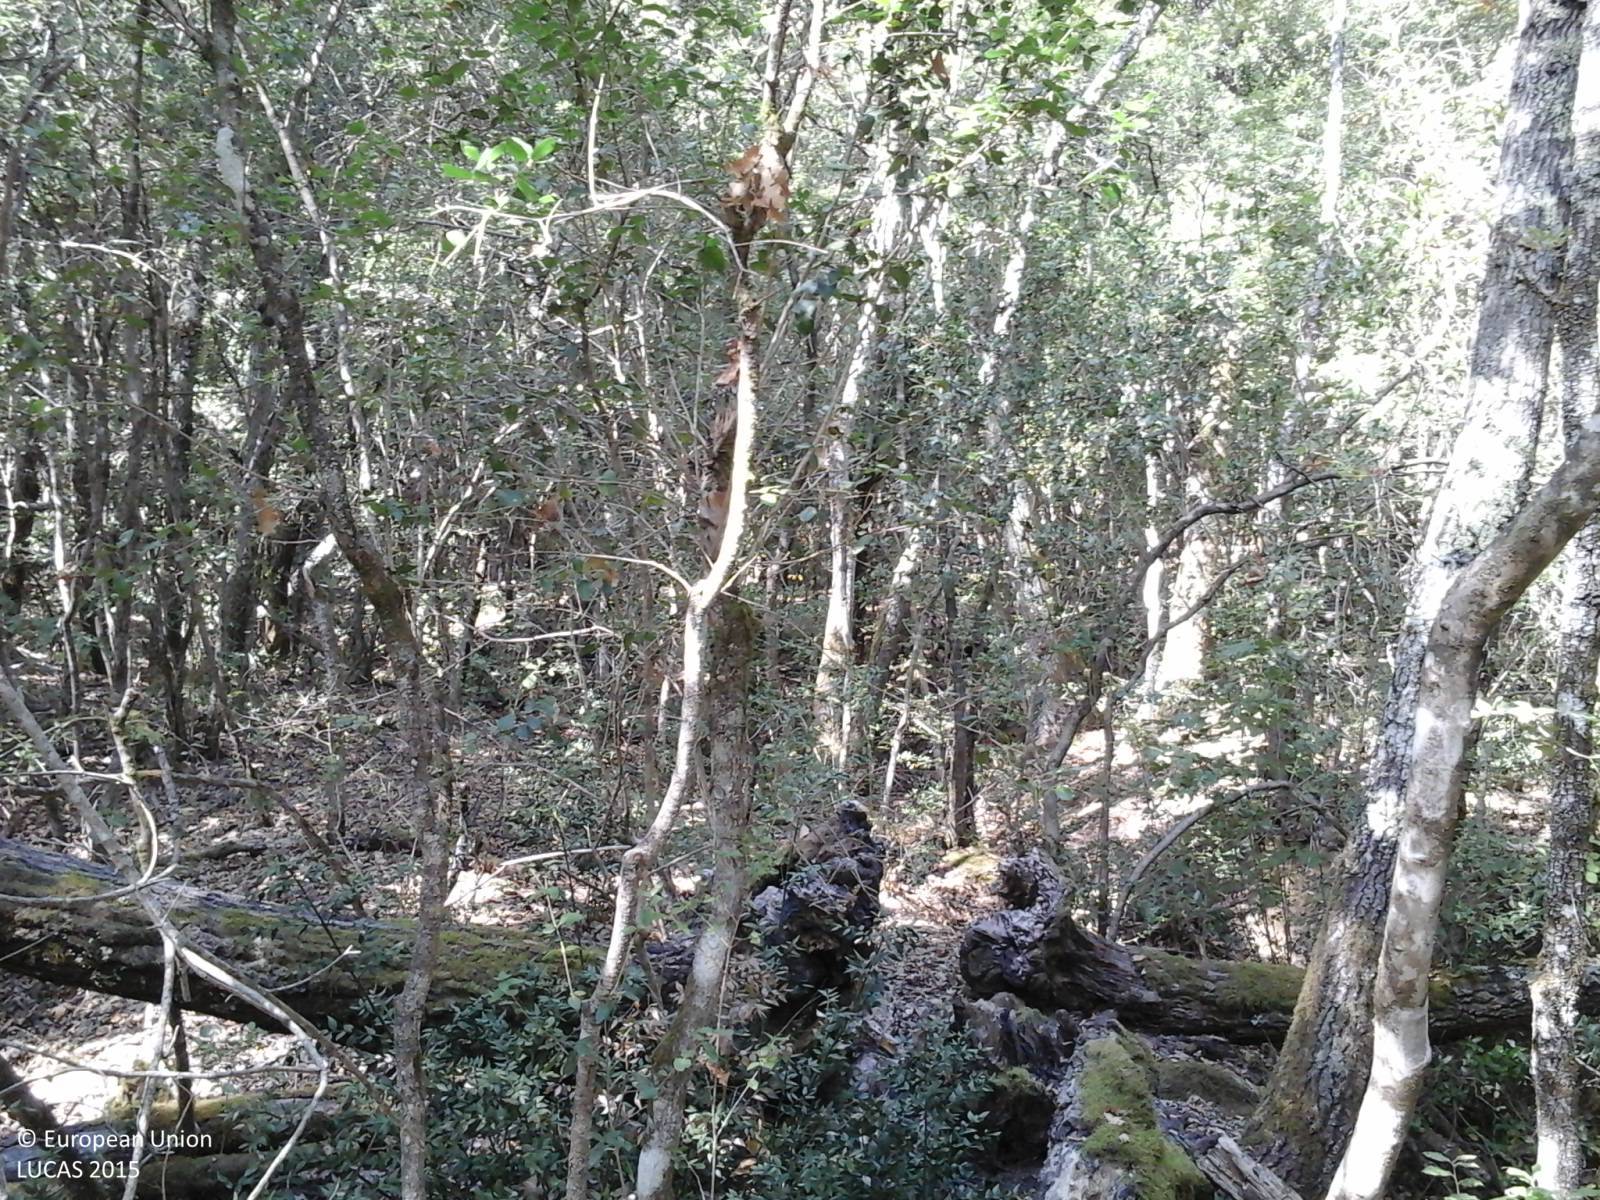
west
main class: Woodland
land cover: Broadleaved woodland
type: thermophilous deciduous forest
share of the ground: > 75 %
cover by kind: broadleaved forest trees 90 %, shrubs 10 %
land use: Forestry
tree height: > 5 m
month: September
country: IT
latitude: 43.1211
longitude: 10.6984
